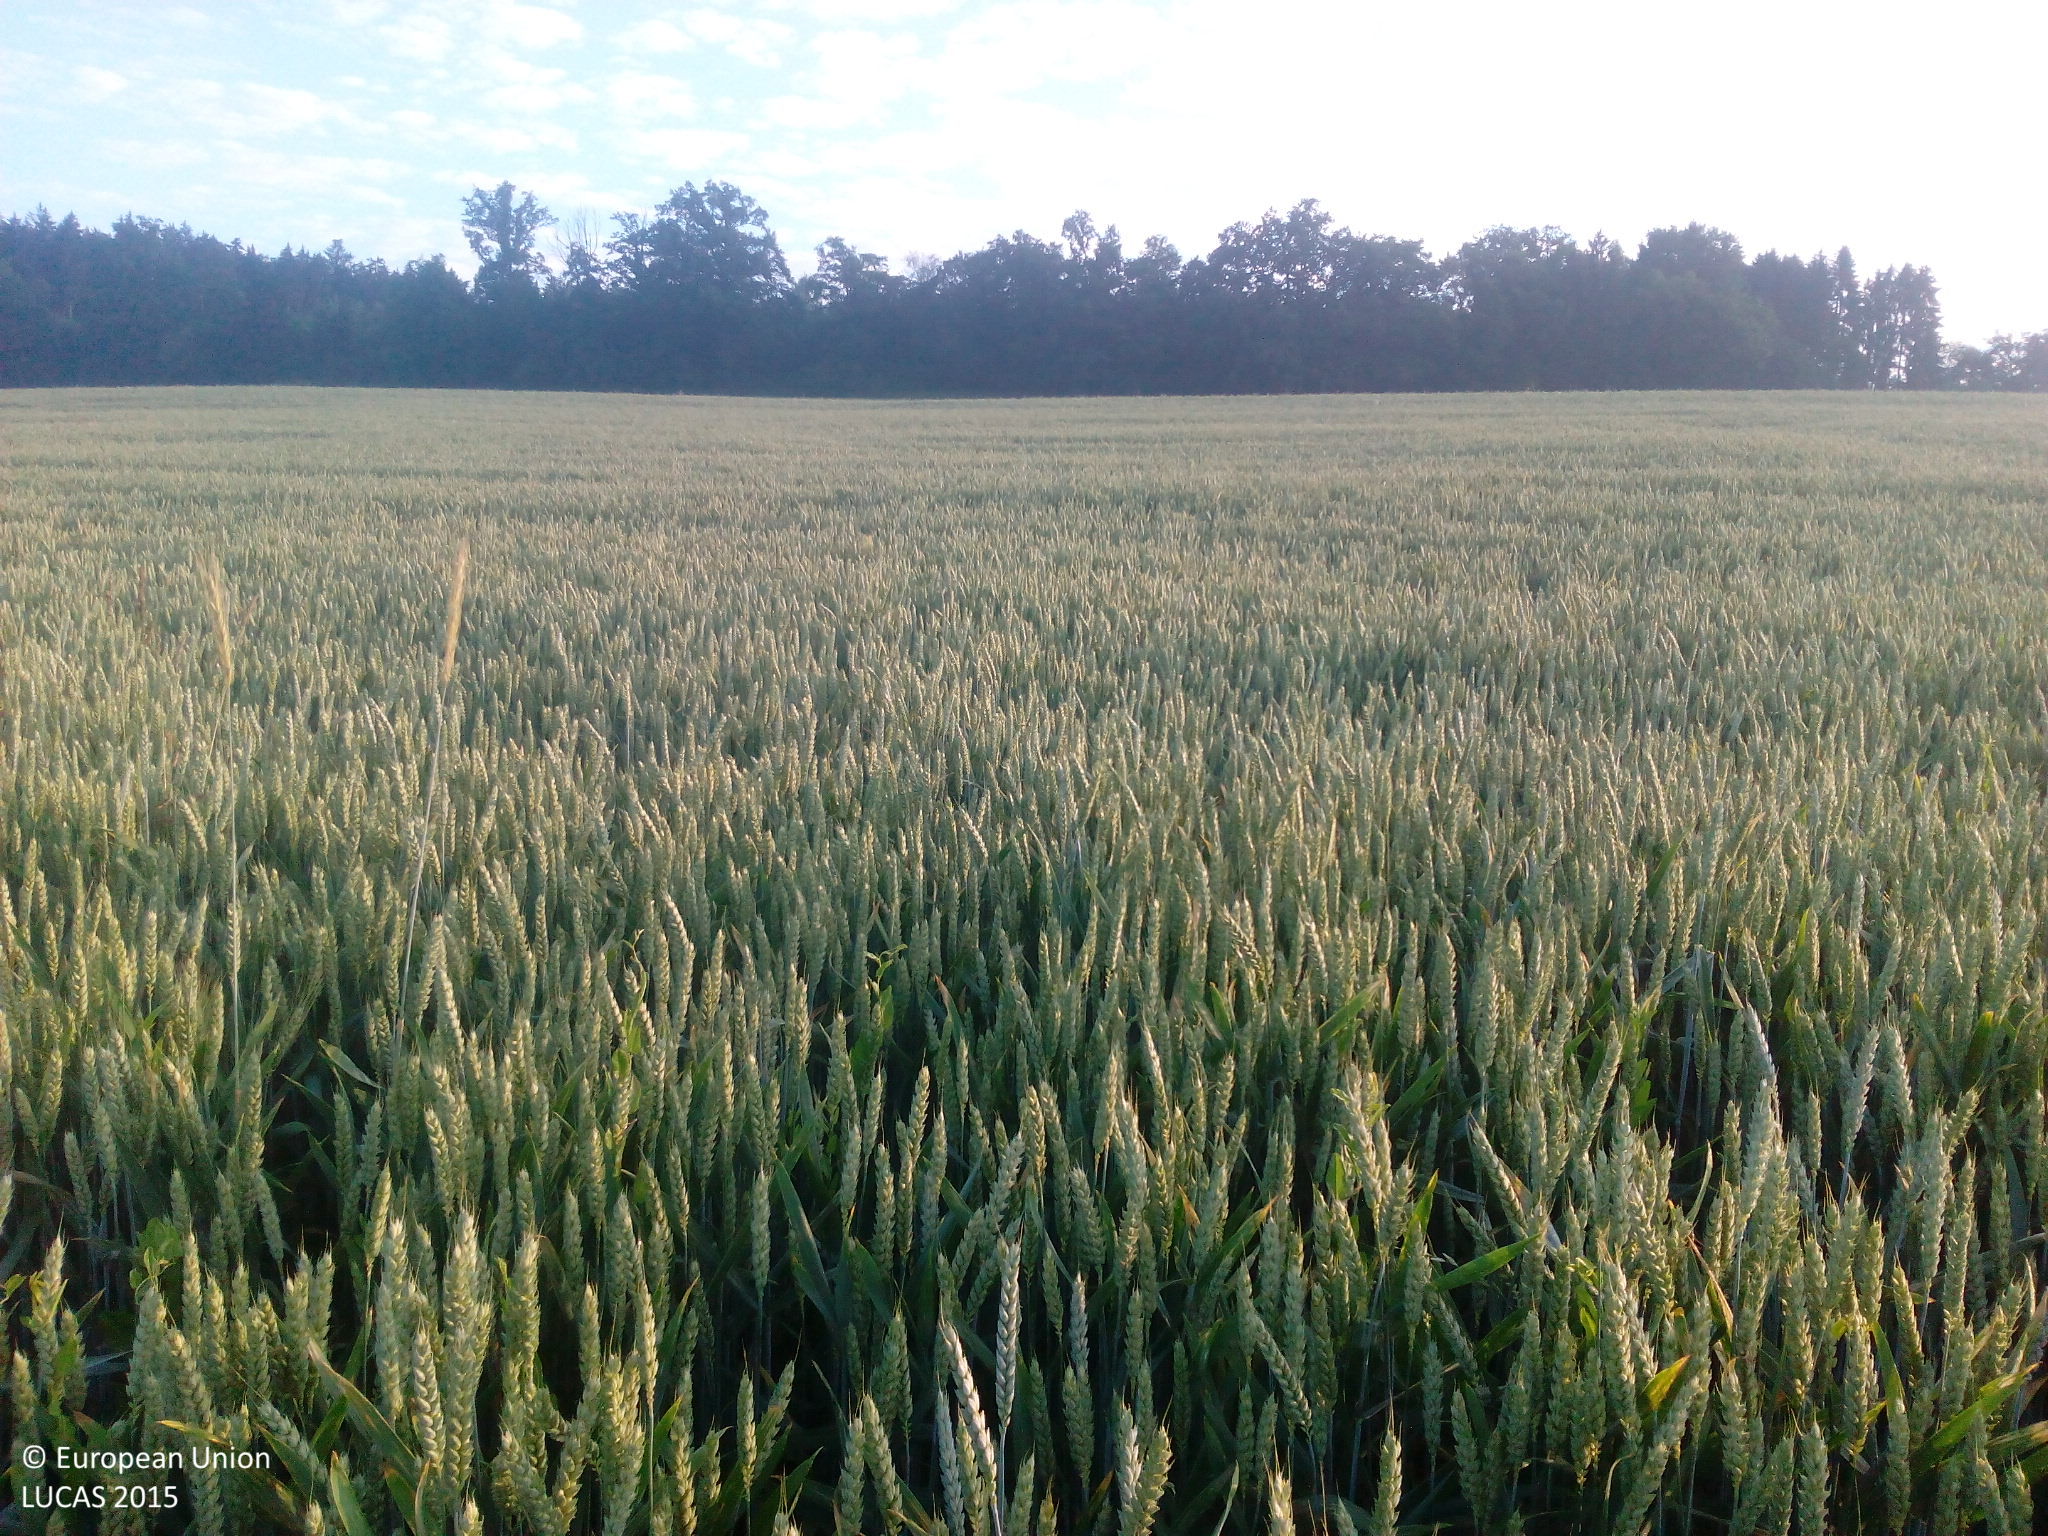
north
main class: Cropland
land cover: Common wheat
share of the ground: > 75 %
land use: Agriculture (excluding fallow land and kitchen gardens)
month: July
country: DE
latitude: 48.8678
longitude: 10.8857
